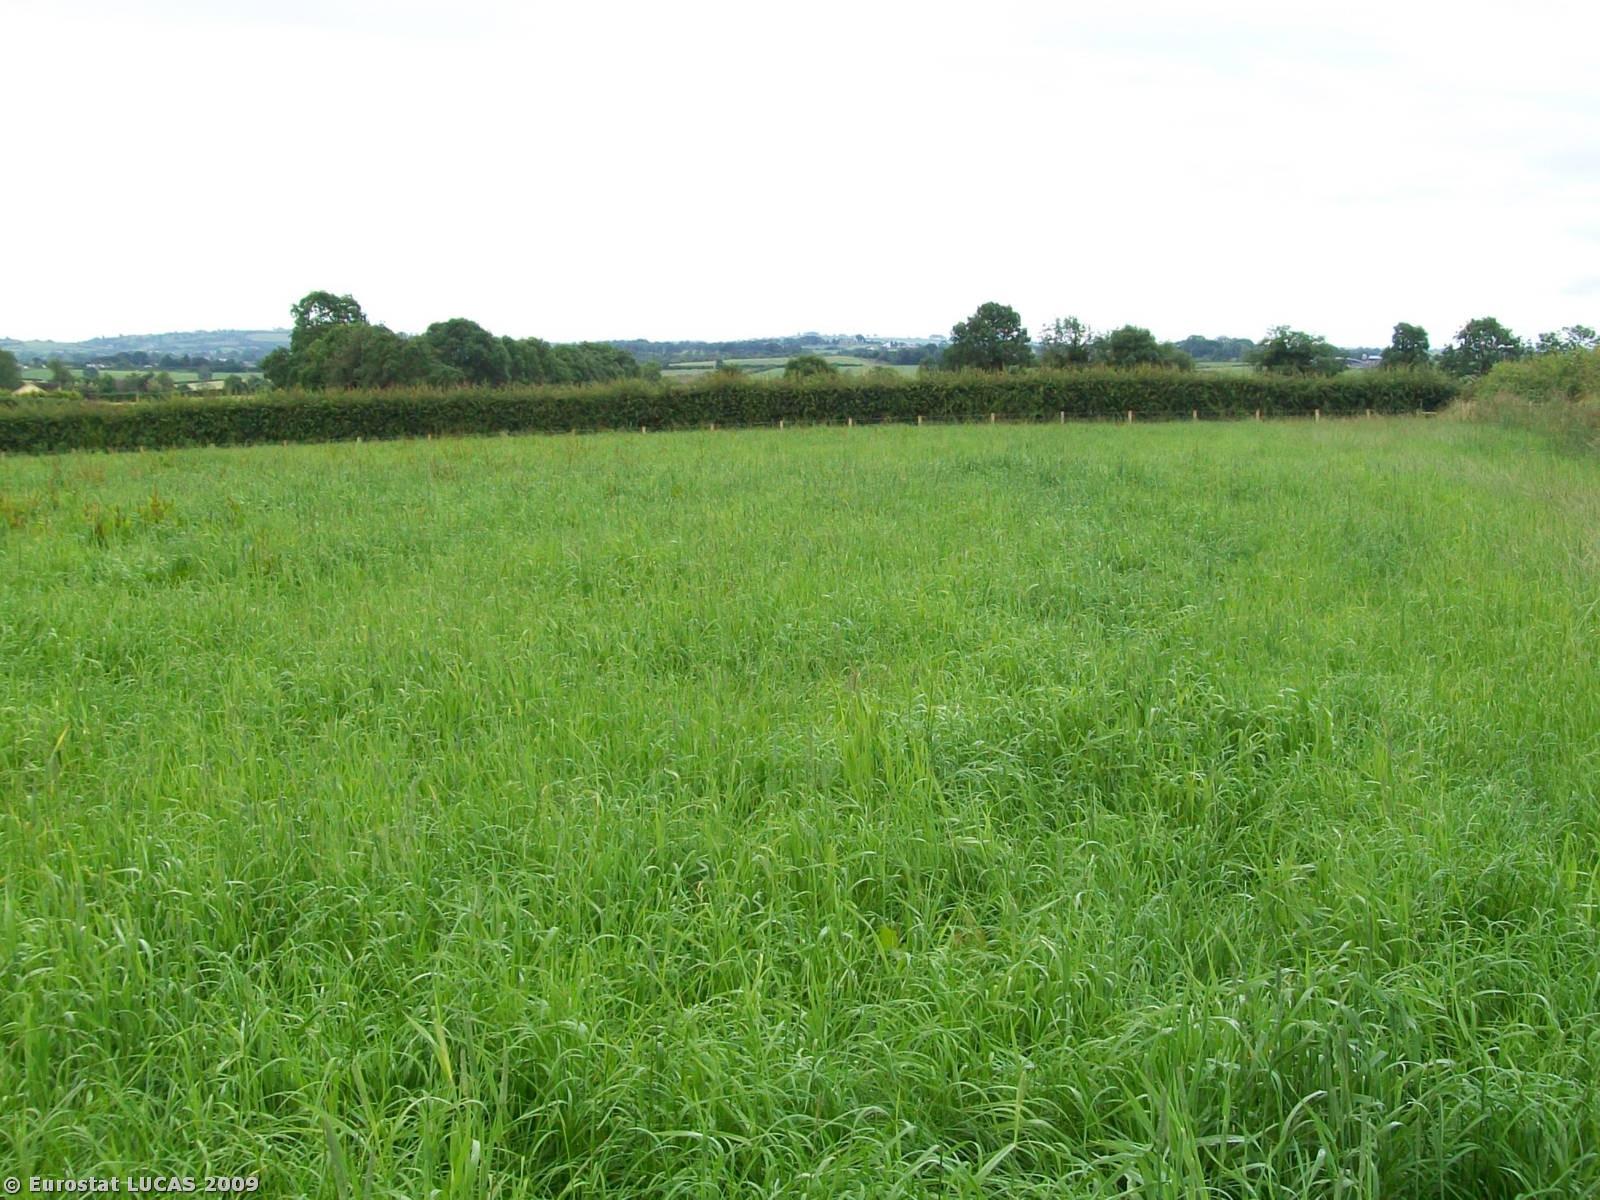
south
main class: Grassland
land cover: Grassland without tree/shrub cover
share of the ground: > 75 %
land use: Agriculture (excluding fallow land and kitchen gardens)
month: July
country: GB
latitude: 54.6621
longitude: -6.6704
